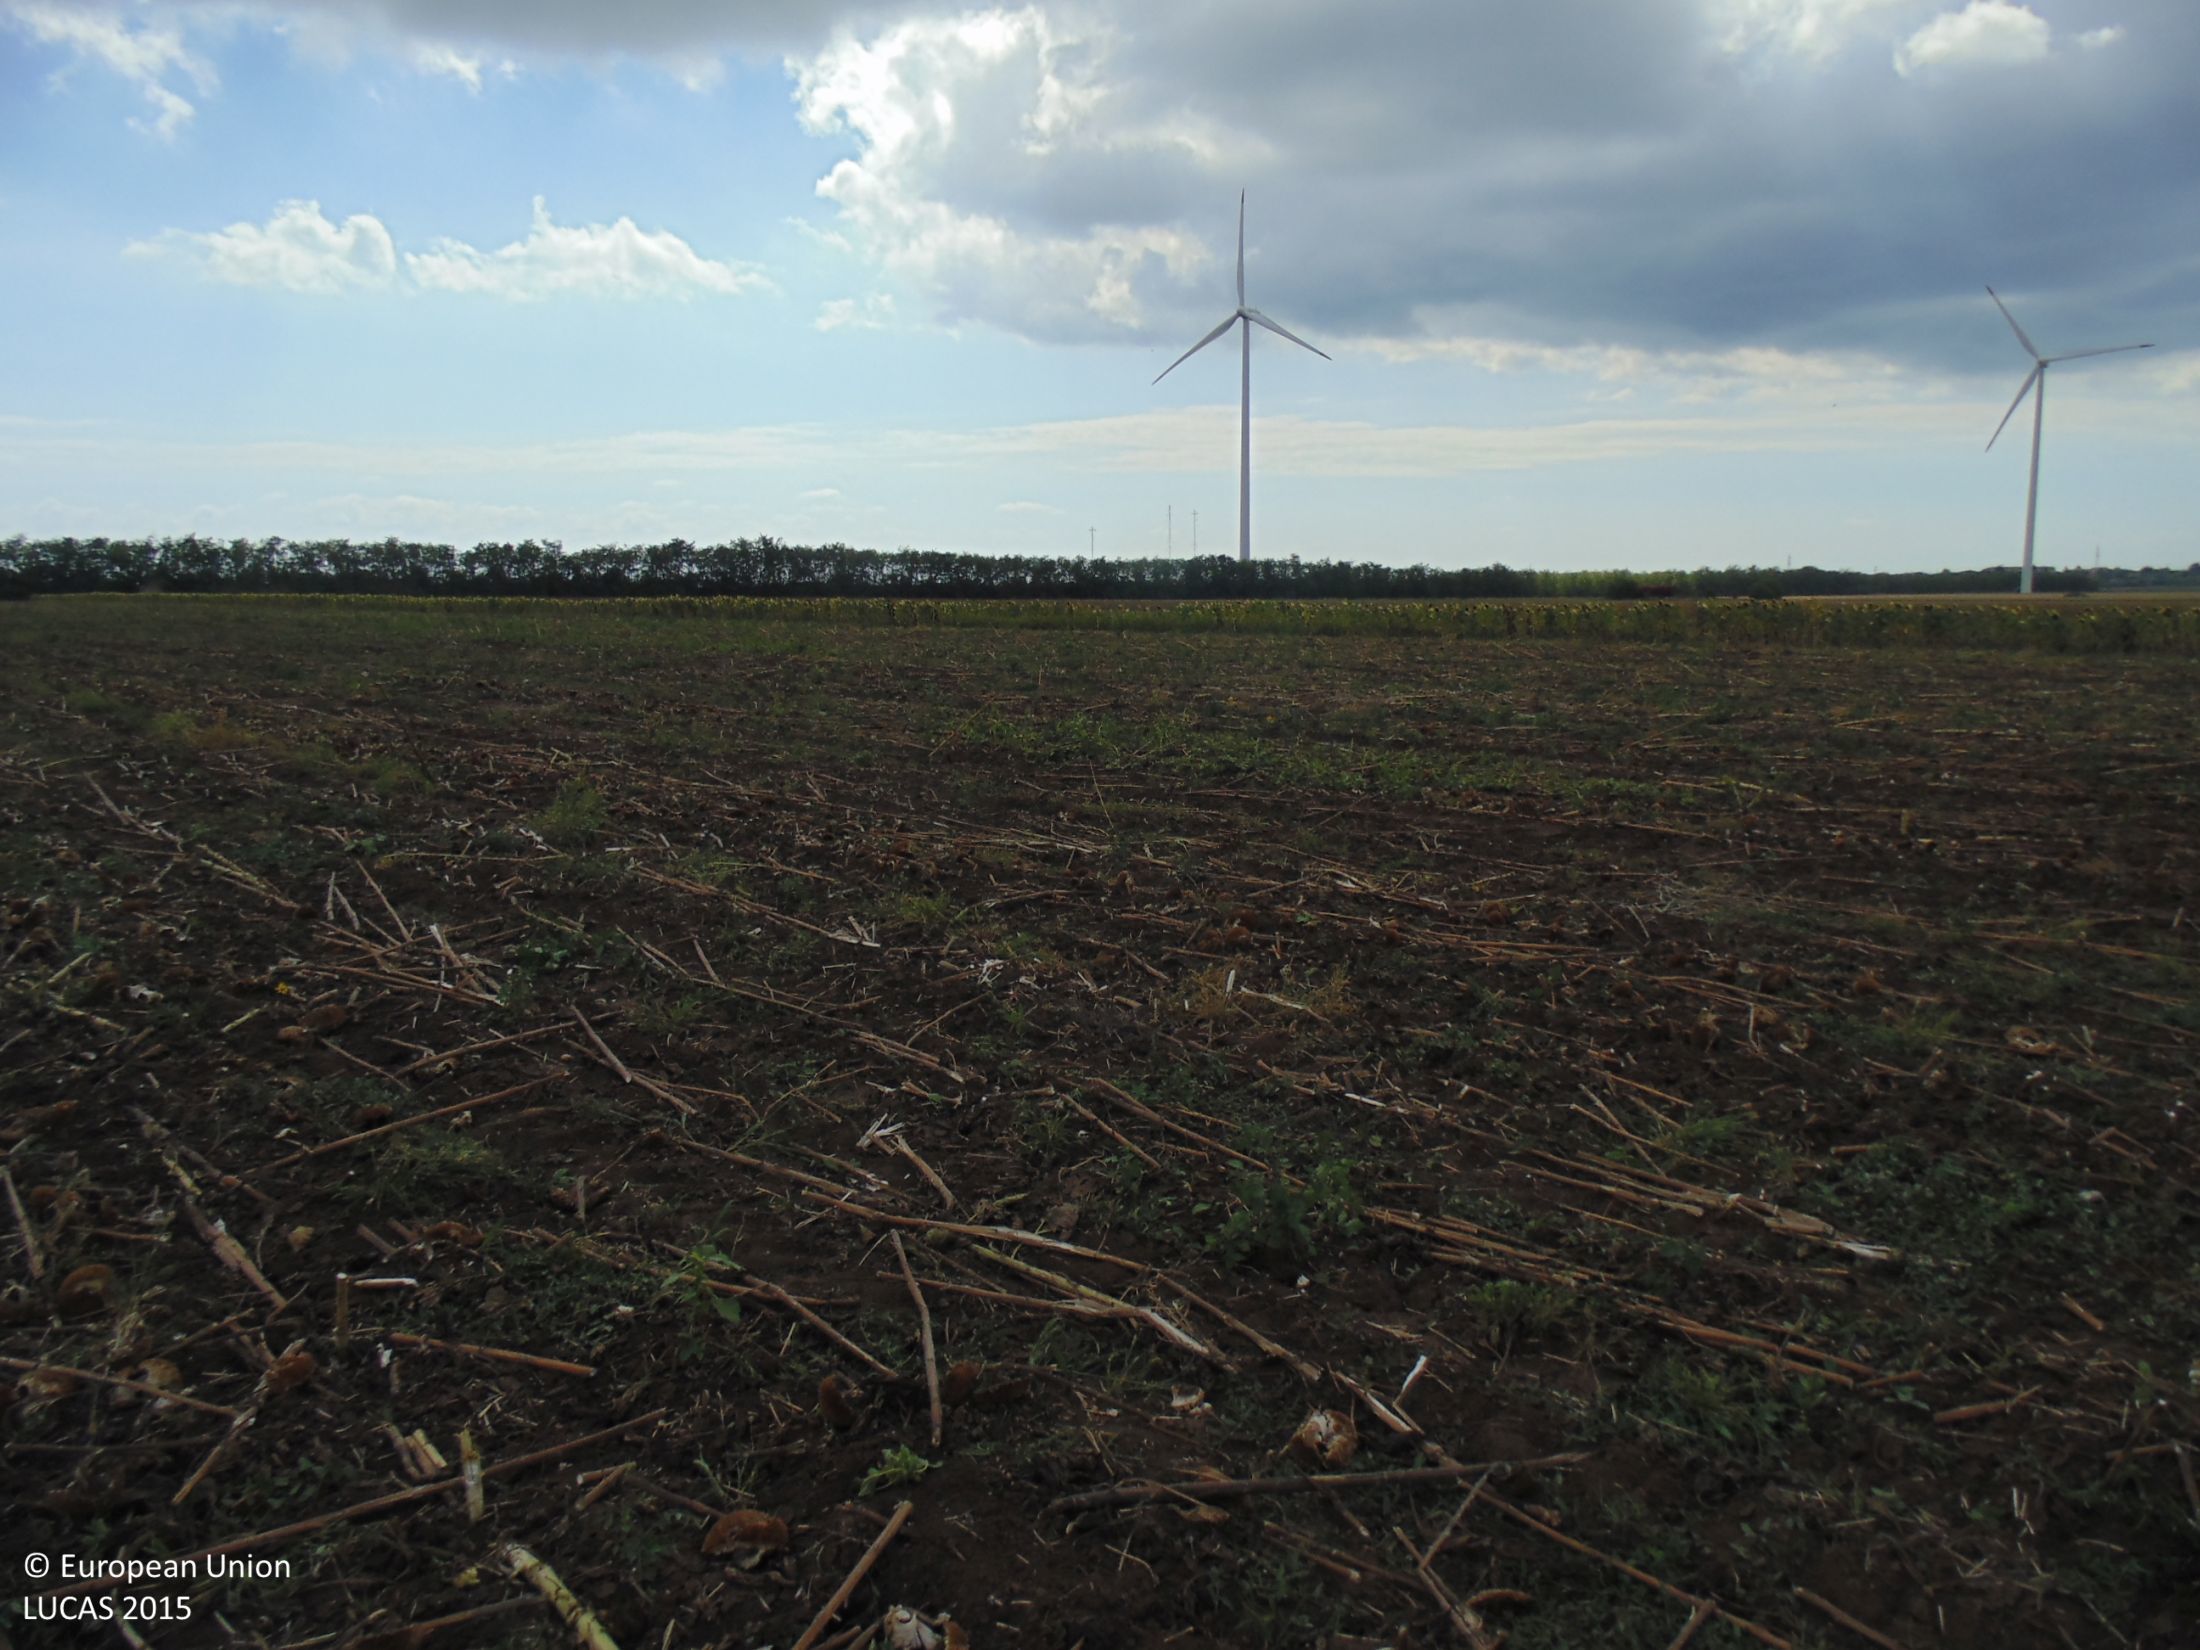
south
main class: Cropland
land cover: Sunflower
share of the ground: < 10 %
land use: Agriculture (excluding fallow land and kitchen gardens)
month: September
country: BG
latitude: 43.4215
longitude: 28.4254
